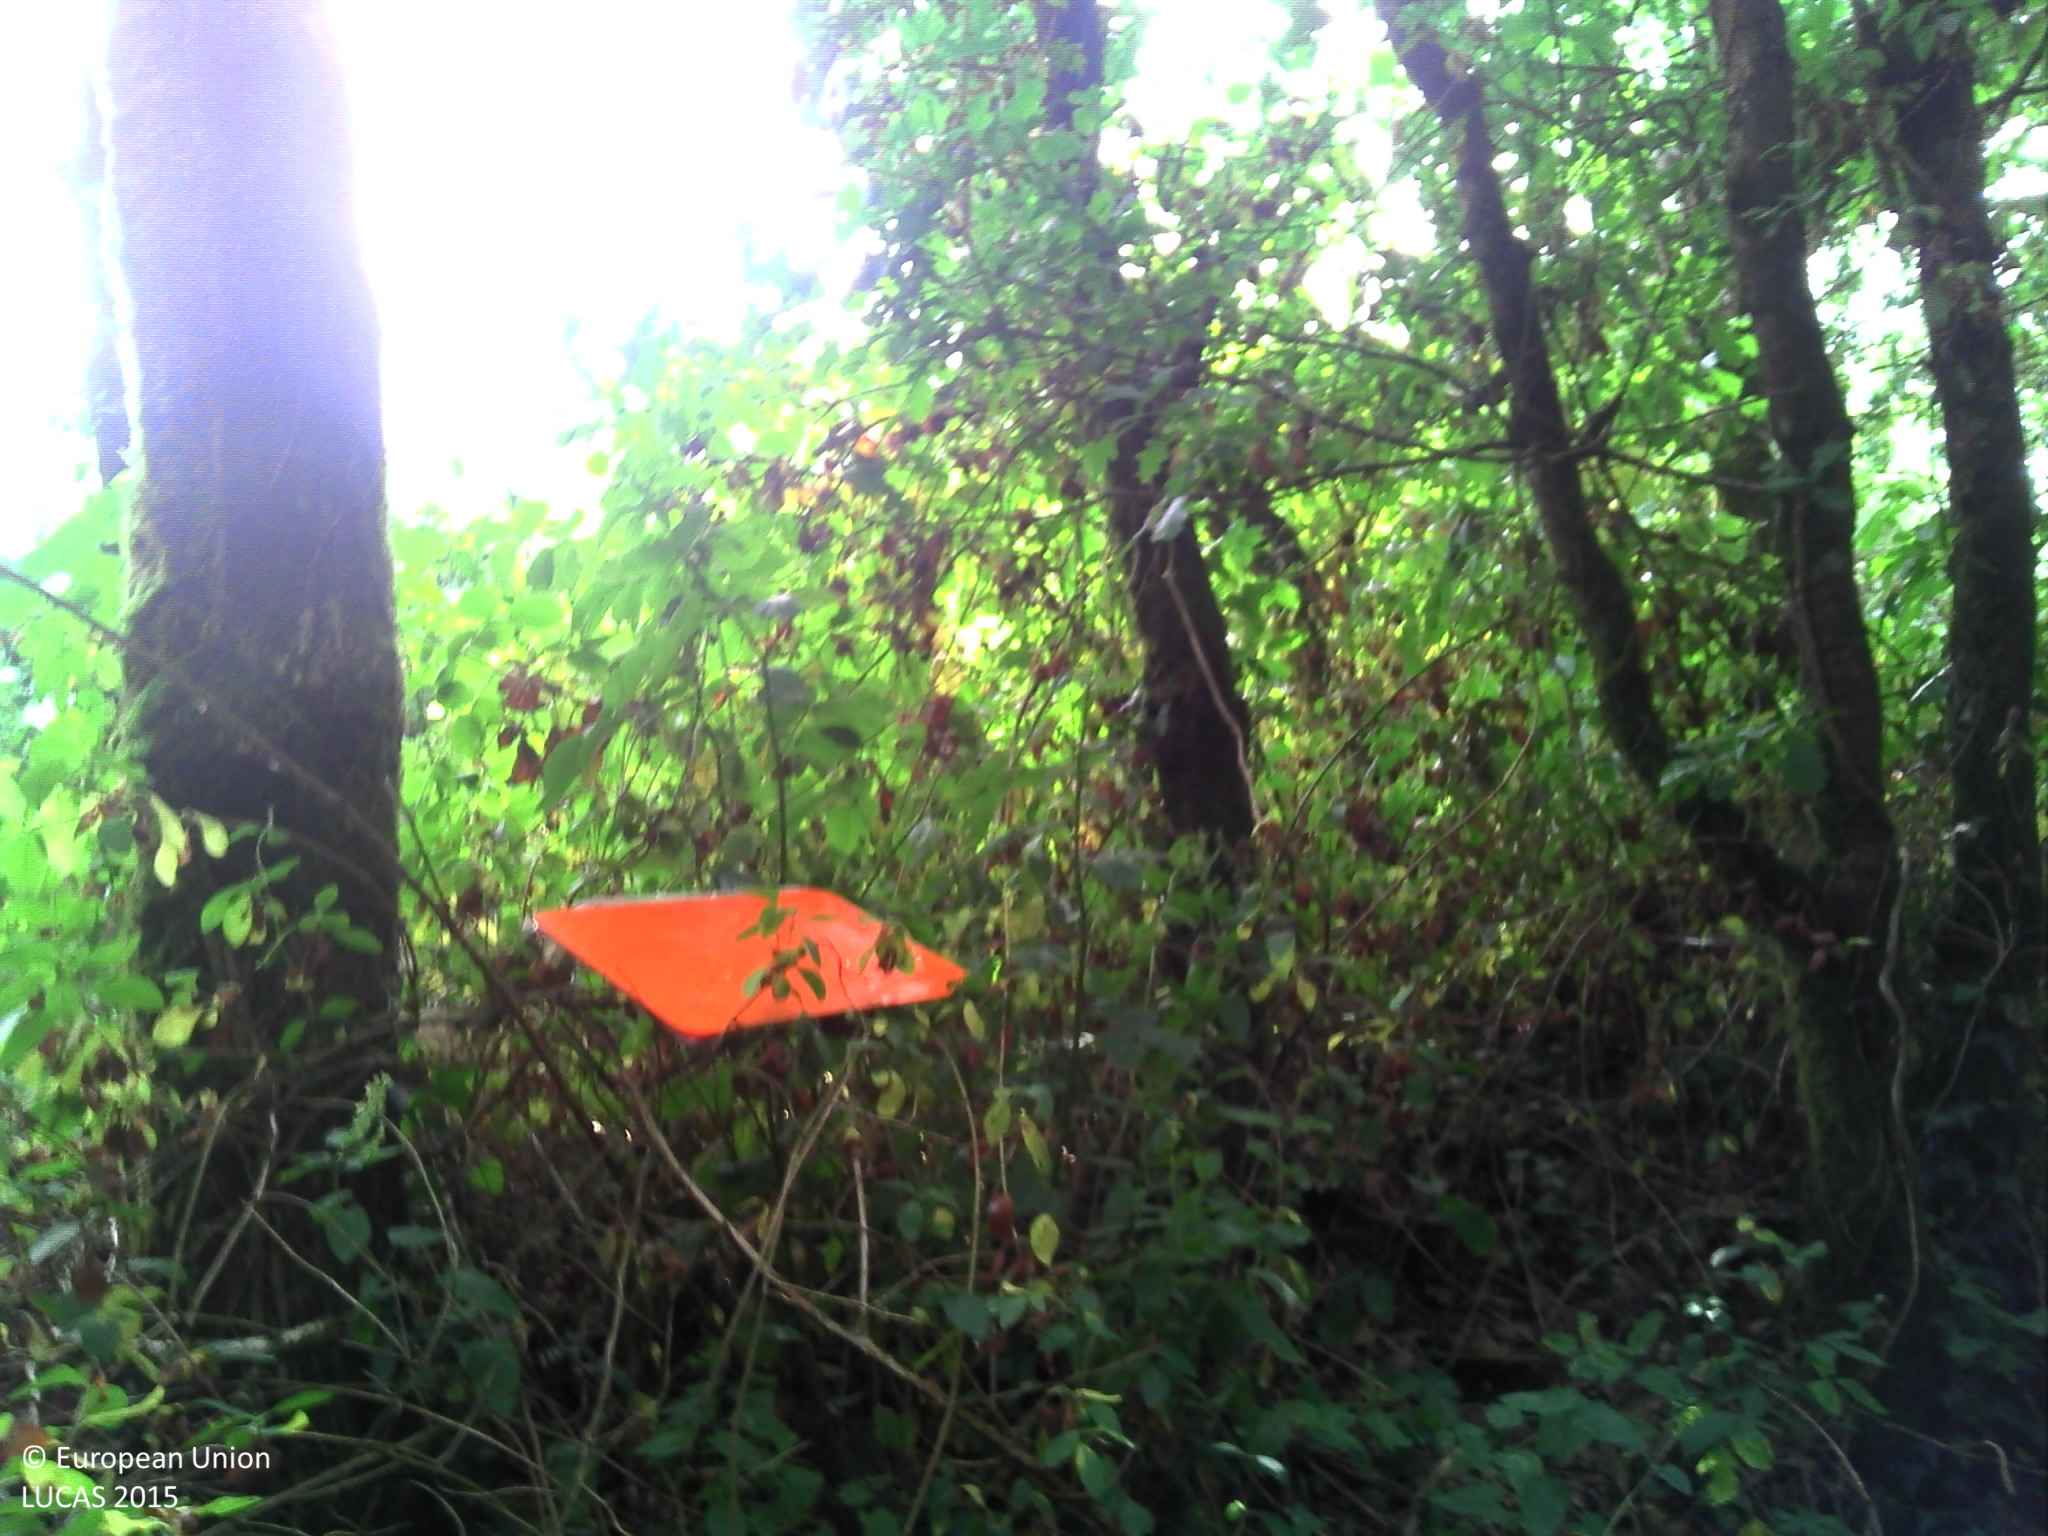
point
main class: Woodland
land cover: Spruce dominated coniferous woodland
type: hemiboreal forest and nemoral coniferous forest and mixed broadleaved-coniferous forest
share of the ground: > 75 %
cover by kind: herbaceous plants 70 %, coniferous forest trees 20 %, unconsolidated bare surface 10 %
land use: Forestry
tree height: > 5 m
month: July
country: FR
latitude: 48.6257
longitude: -3.5251
